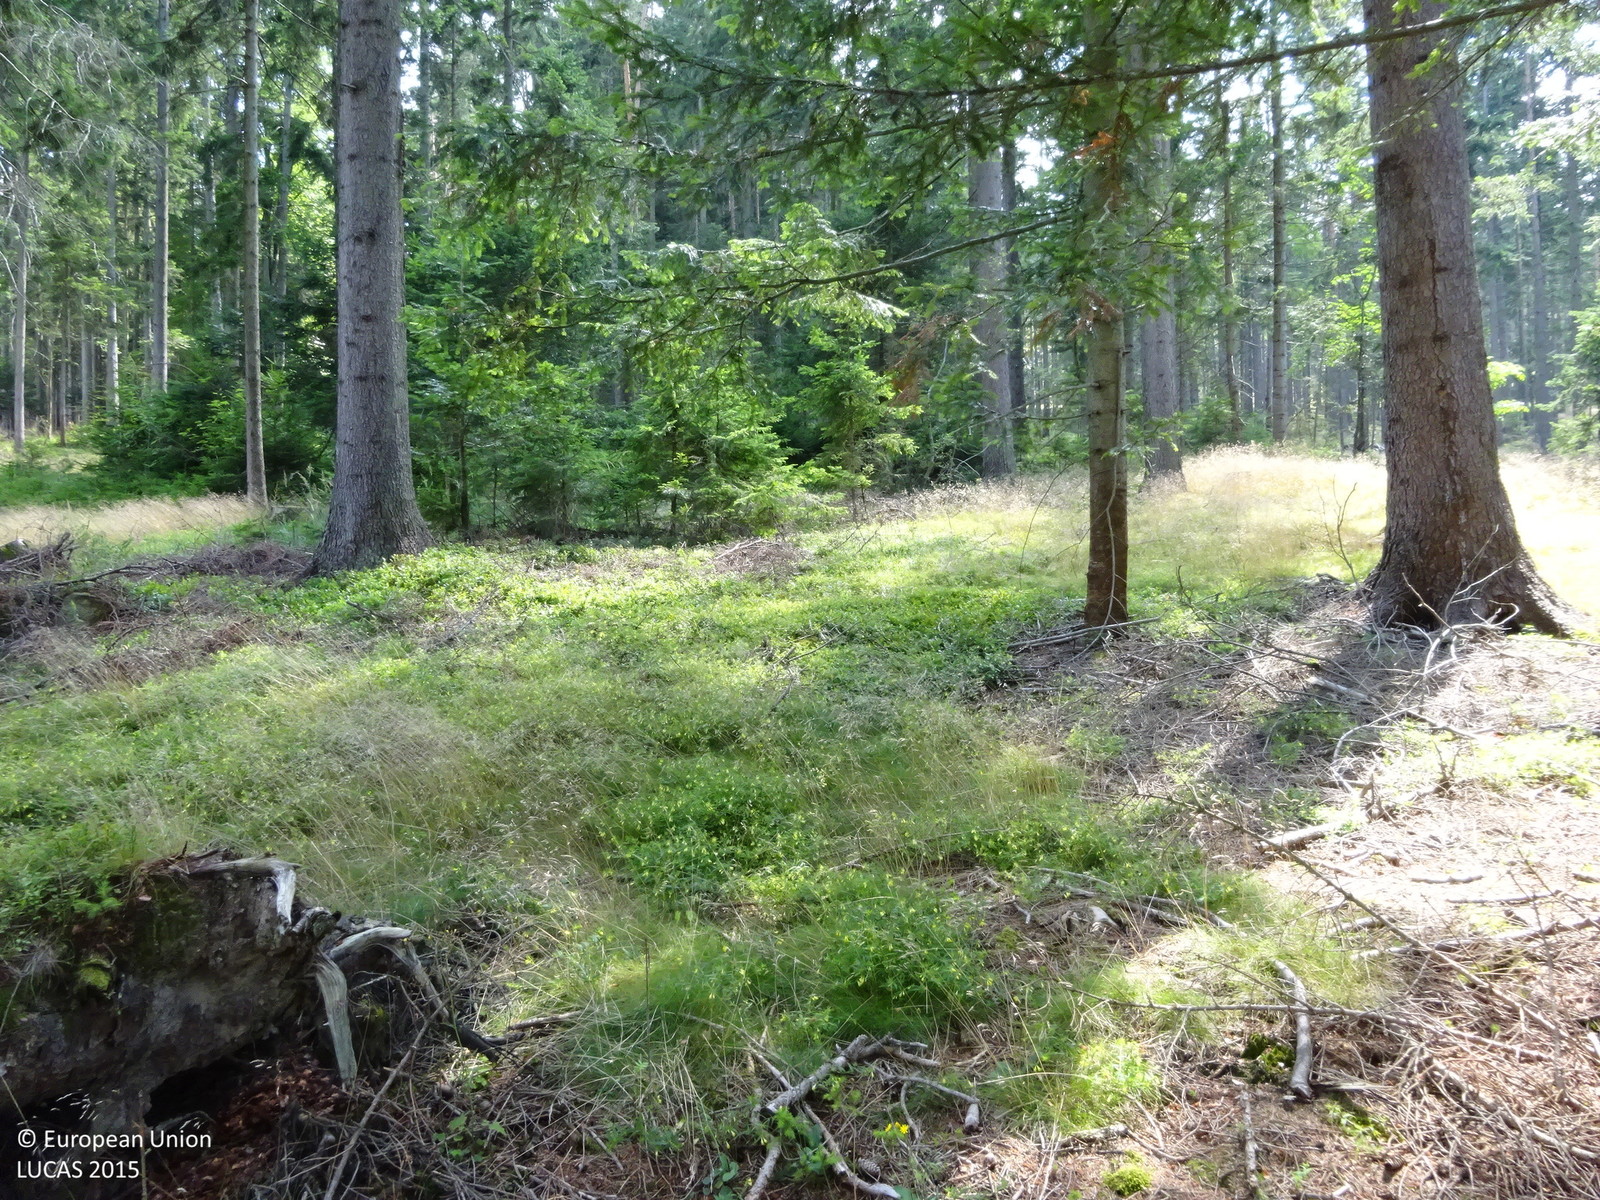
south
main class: Woodland
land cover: Spruce dominated coniferous woodland
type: alpine coniferous forest
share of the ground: > 75 %
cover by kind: coniferous forest trees 95 %, herbaceous plants 5 %
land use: Forestry
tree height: > 5 m
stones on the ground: < 10 %
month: August
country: AT
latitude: 47.3154
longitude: 15.7558
